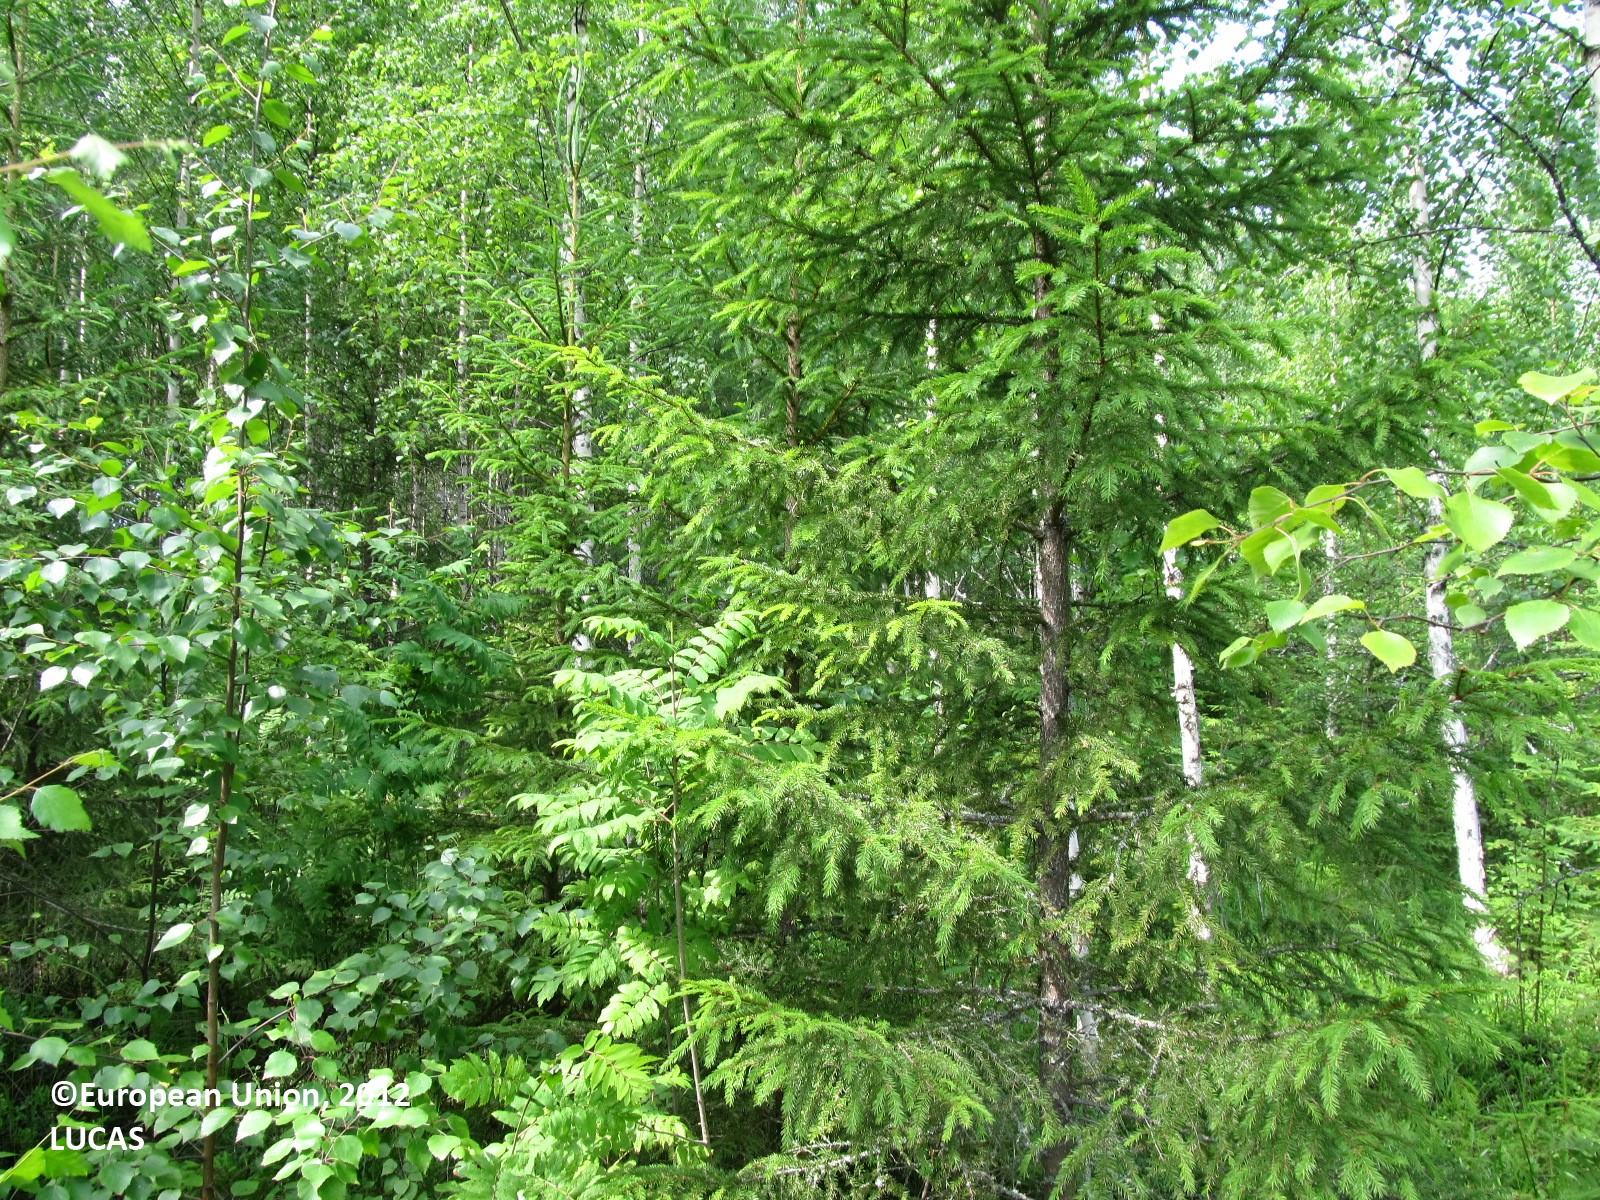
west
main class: Woodland
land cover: Pine dominated mixed woodland
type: boreal forest
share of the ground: 25 - 50 %
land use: Forestry
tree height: < 5 m
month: July
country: FI
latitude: 61.9286
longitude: 29.1081
